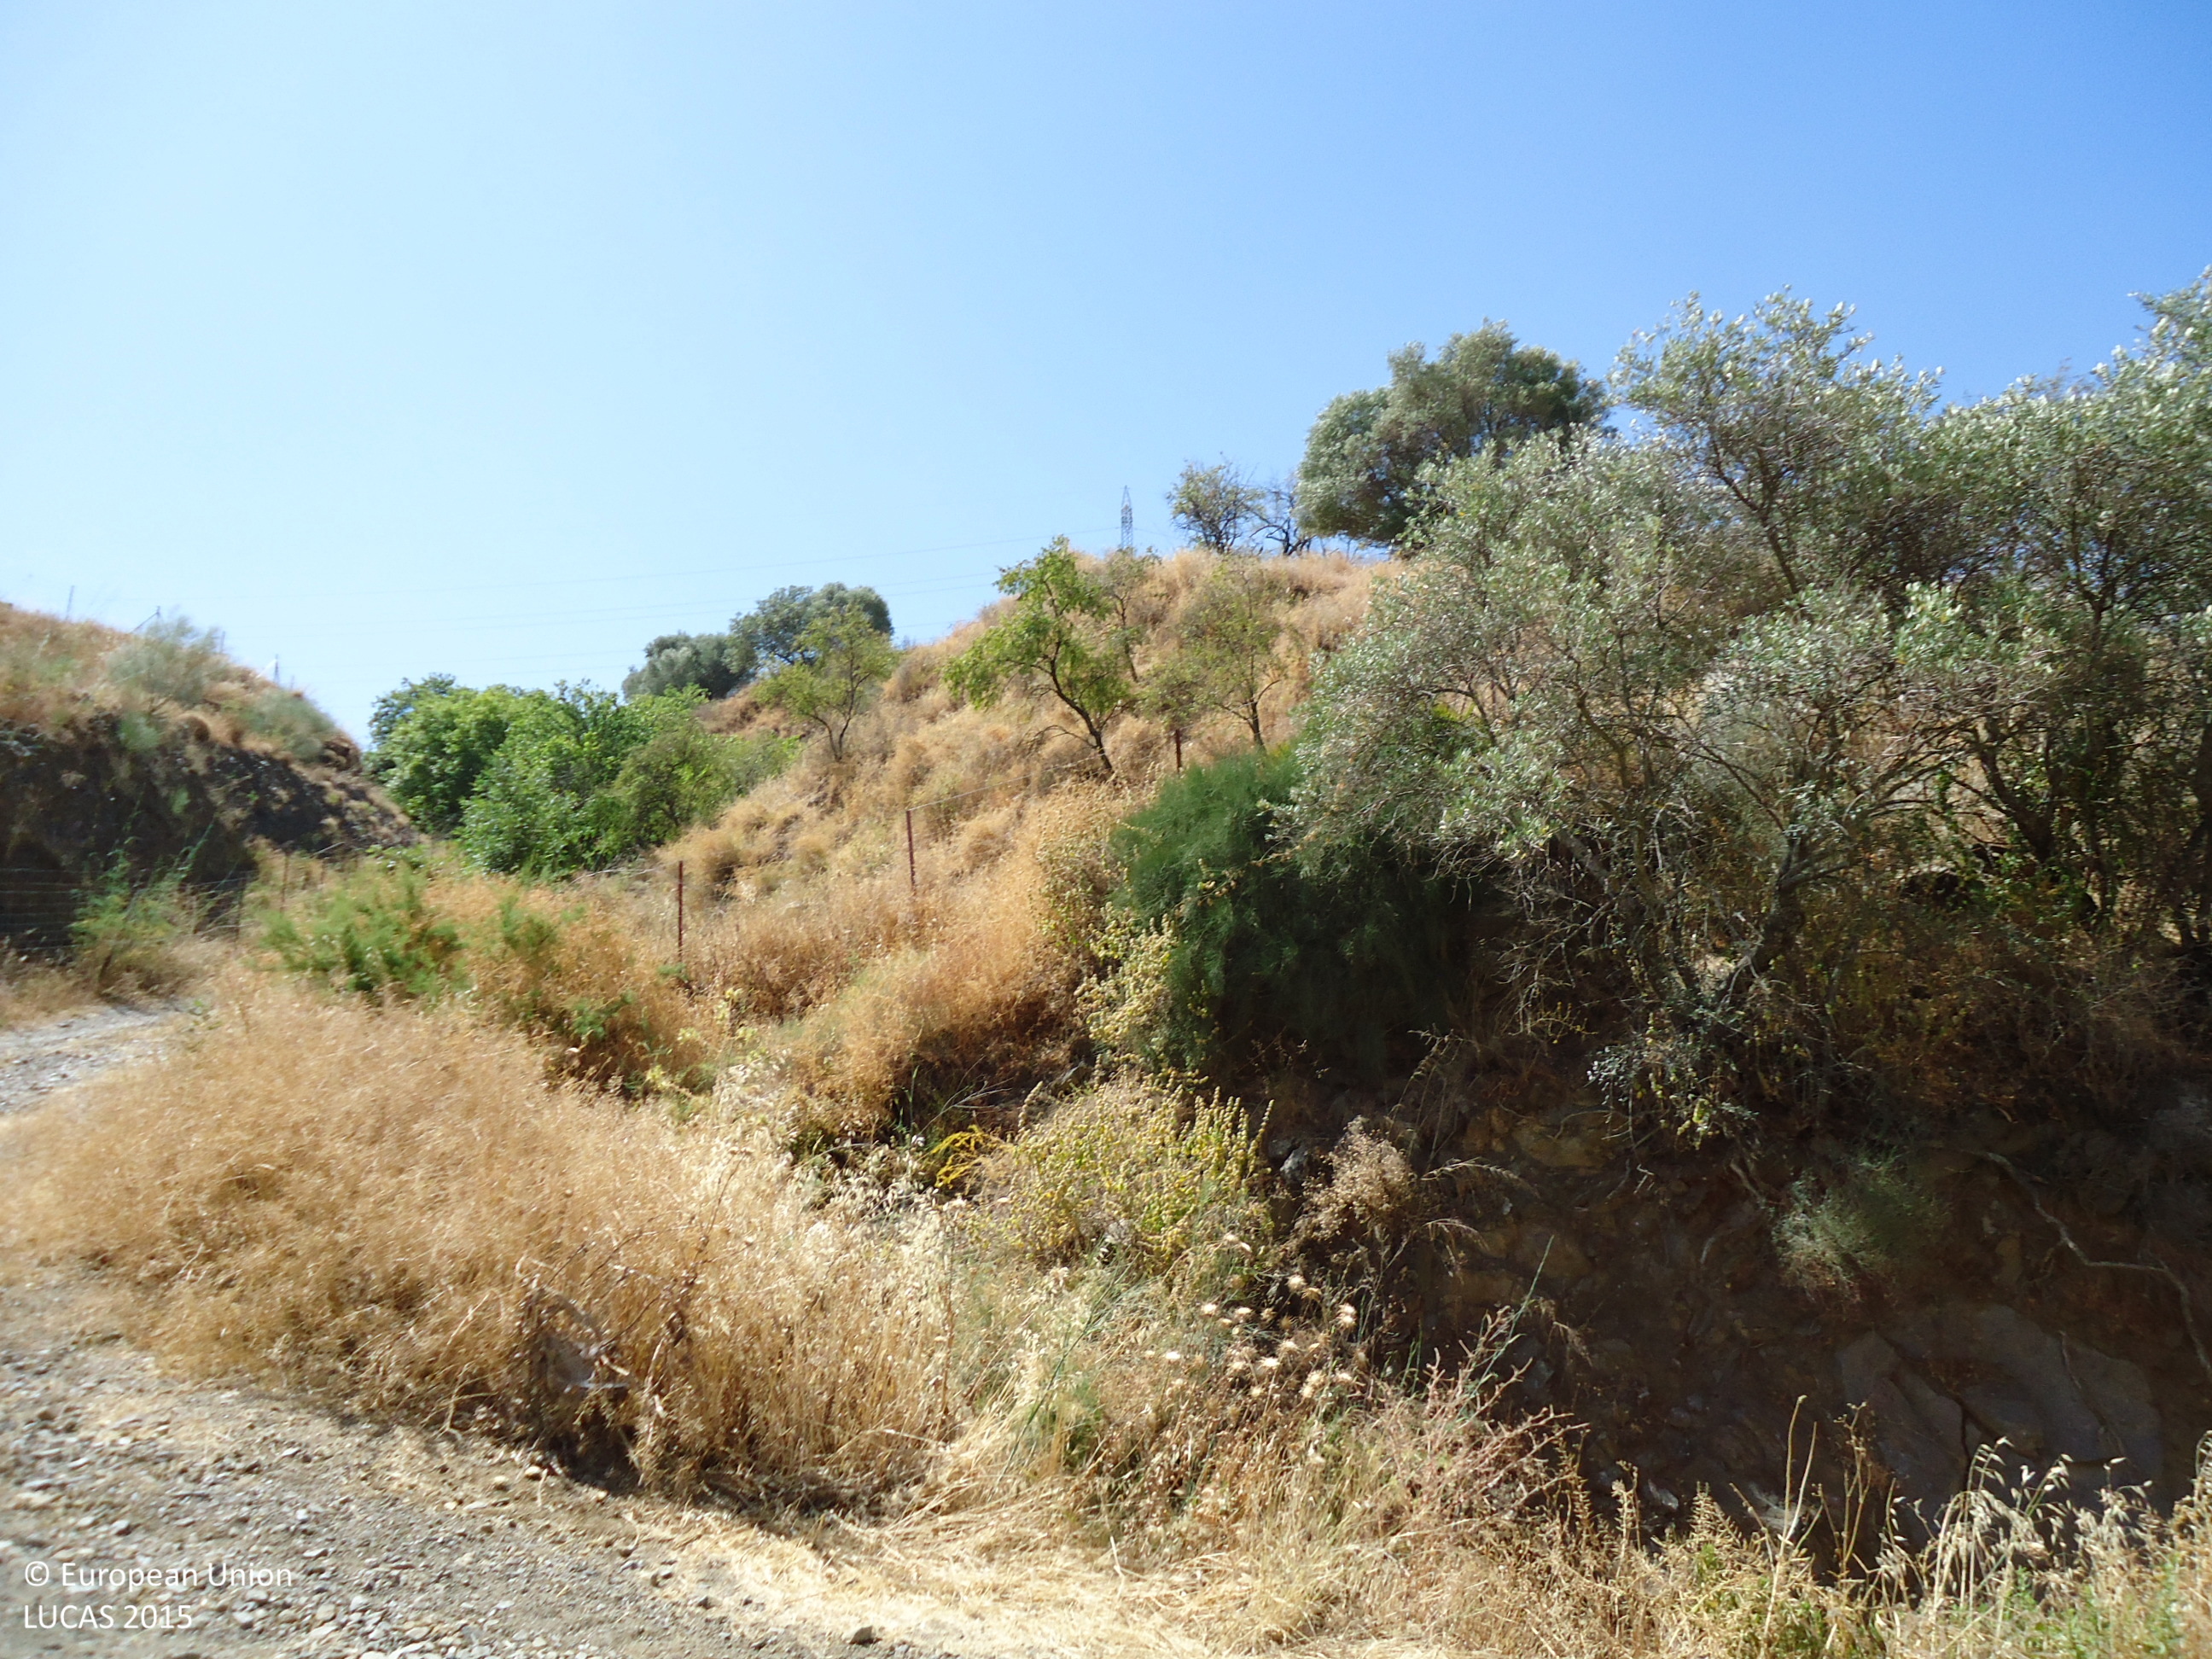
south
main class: Grassland
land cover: Grassland without tree/shrub cover
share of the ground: > 75 %
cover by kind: herbaceous plants 100 %
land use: Agriculture (excluding fallow land and kitchen gardens)
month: June
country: ES
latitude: 36.8244
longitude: -4.7836
